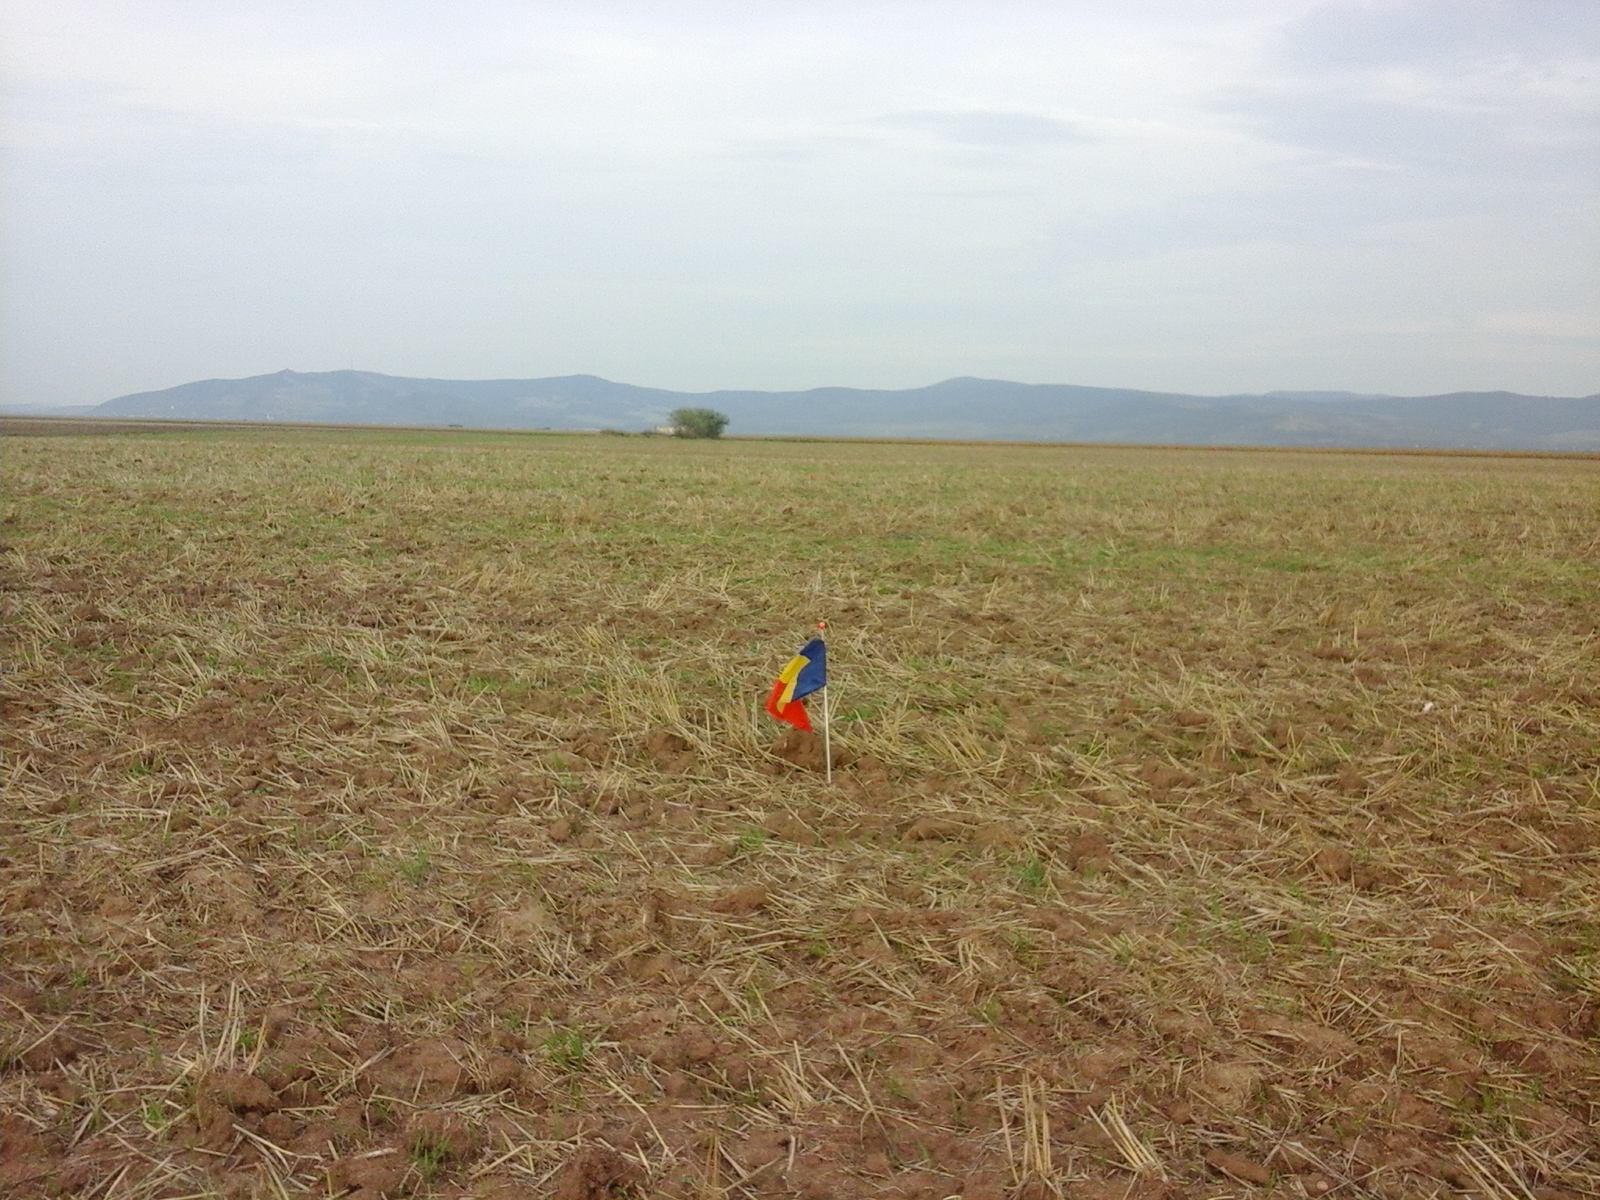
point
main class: Cropland
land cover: Common wheat
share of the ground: < 10 %
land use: Agriculture (excluding fallow land and kitchen gardens)
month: August
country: RO
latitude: 46.2159
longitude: 21.5348
